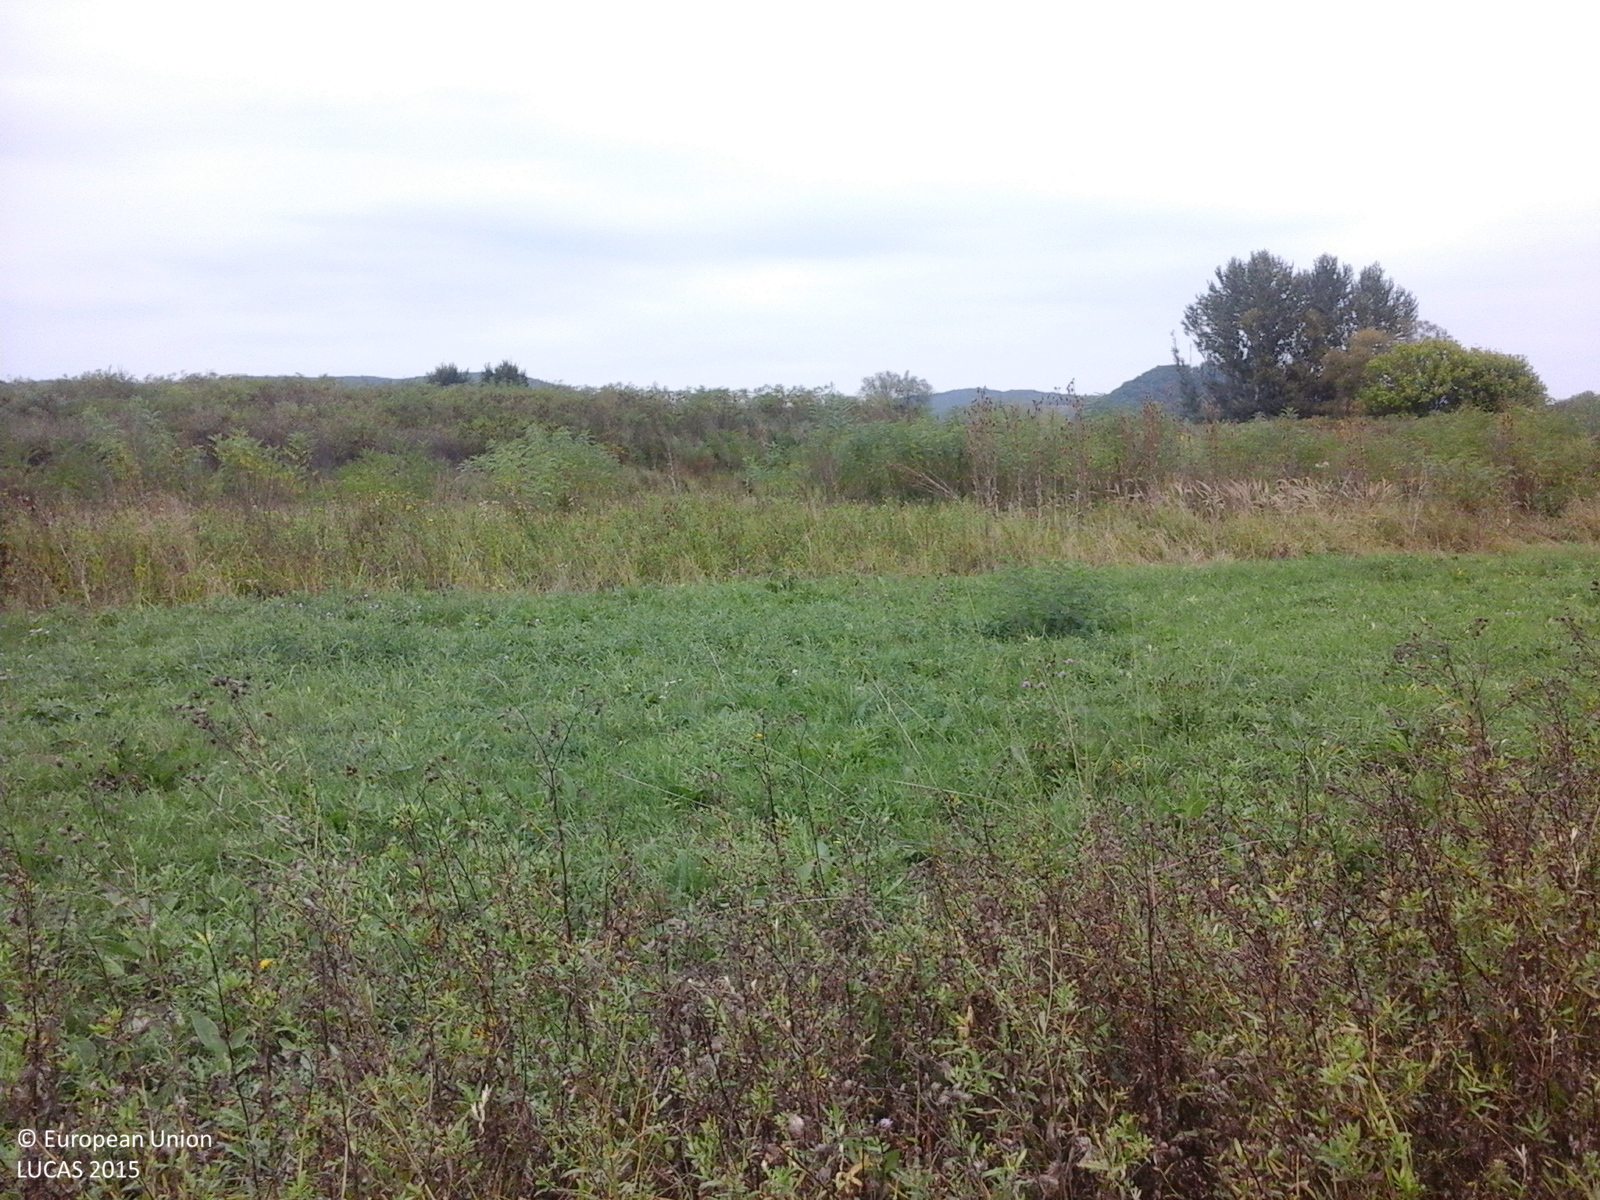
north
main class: Grassland
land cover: Spontaneously vegetated surfaces
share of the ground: > 75 %
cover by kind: herbaceous plants 100 %
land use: Fallow land
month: September
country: RO
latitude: 45.9936
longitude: 22.2195
